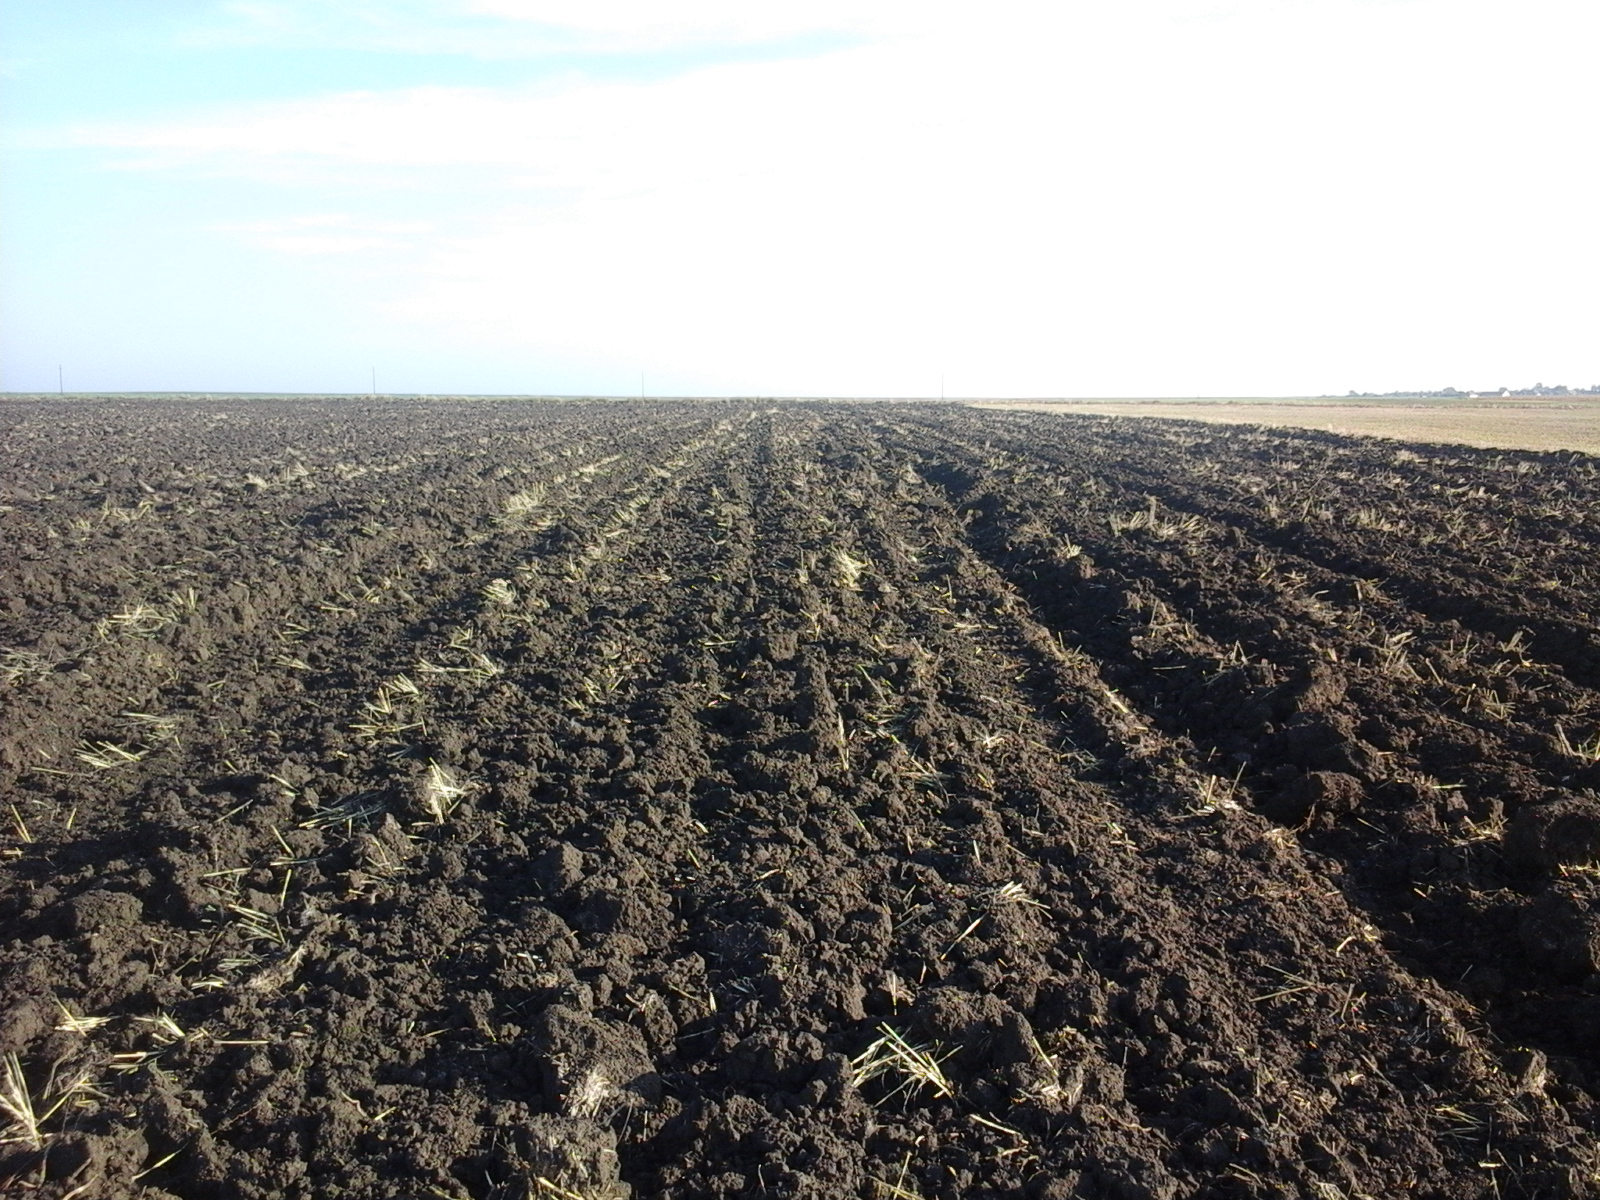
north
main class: Cropland
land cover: Common wheat
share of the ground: < 10 %
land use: Agriculture (excluding fallow land and kitchen gardens)
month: August
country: RO
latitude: 46.0161
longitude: 21.0213
